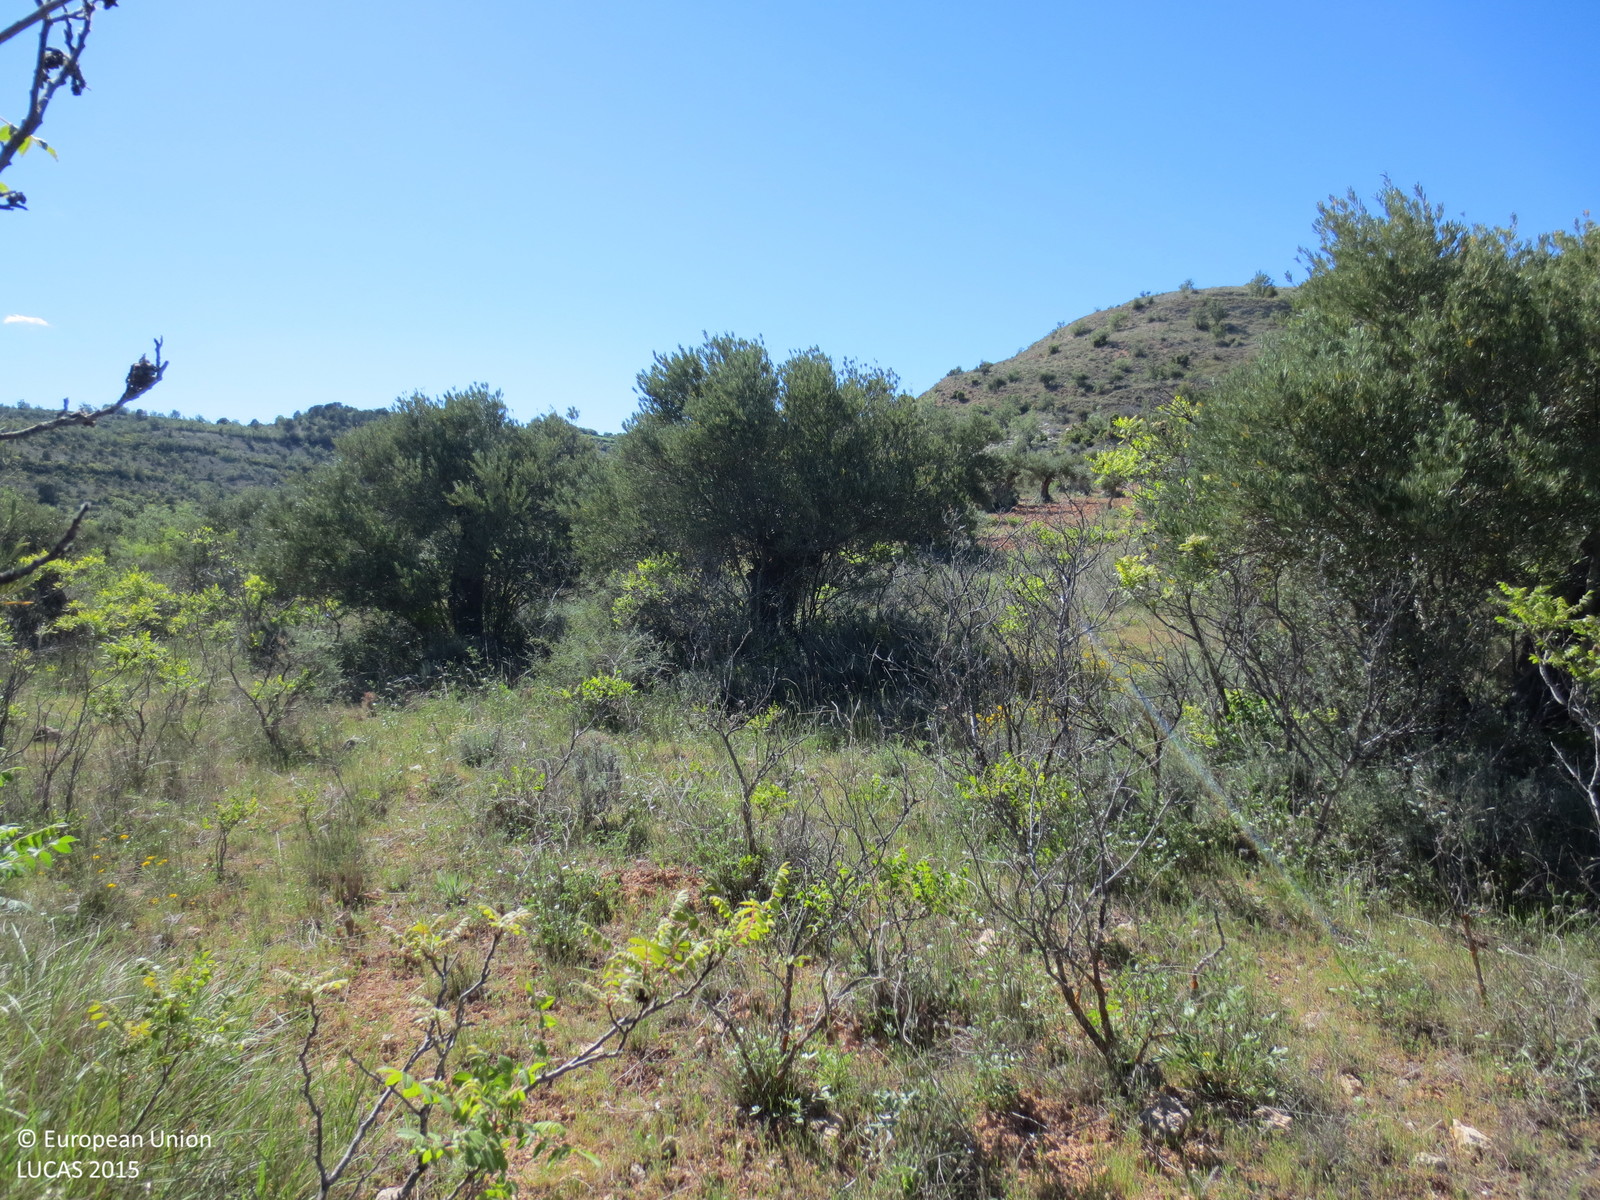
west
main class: Cropland
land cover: Permanent crops (only in case pi)
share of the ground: 50 - 75 %
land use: Abandoned areas
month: May
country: ES
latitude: 40.5365
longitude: -2.5516
